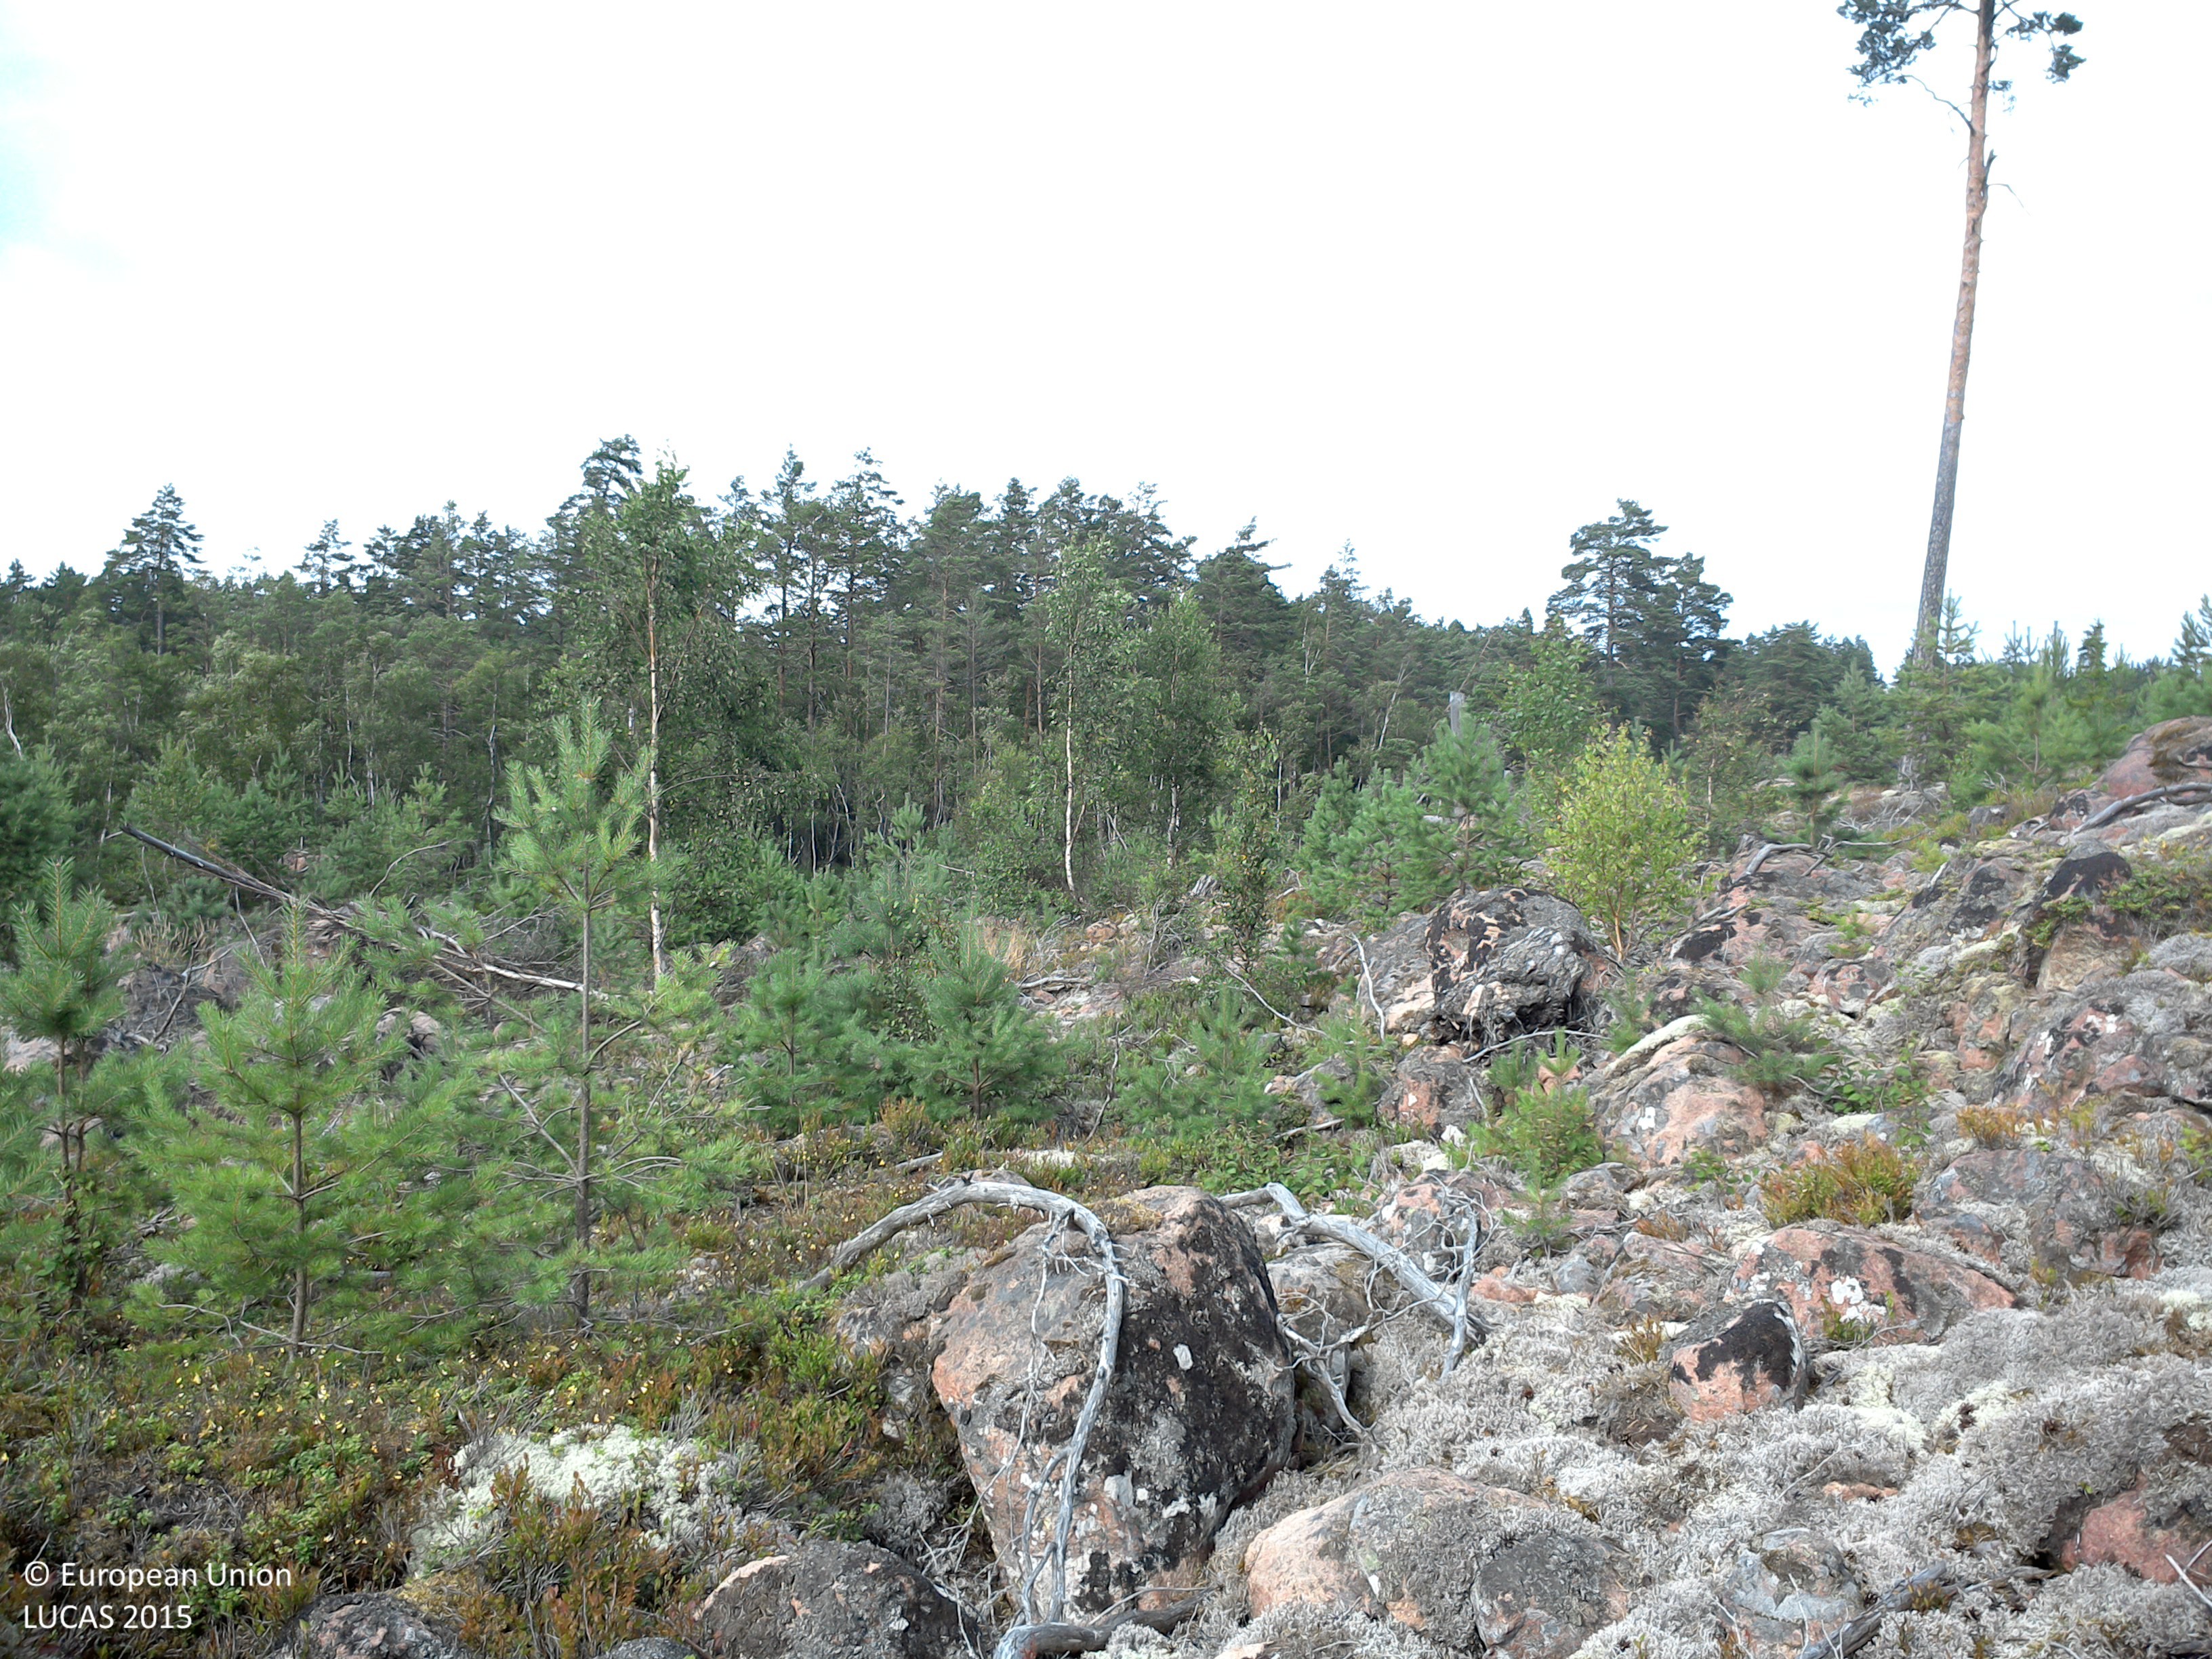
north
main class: Woodland
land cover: Pine dominated coniferous woodland
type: boreal forest
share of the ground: 10 - 25 %
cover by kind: lichens and mosses 50 %, coniferous forest trees 20 %, consolidated bare surface 15 %, broadleaved forest trees 5 %, shrubs 5 %, unconsolidated bare surface 5 %
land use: Forestry
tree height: < 5 m
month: August
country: SE
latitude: 58.2402
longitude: 14.8488
